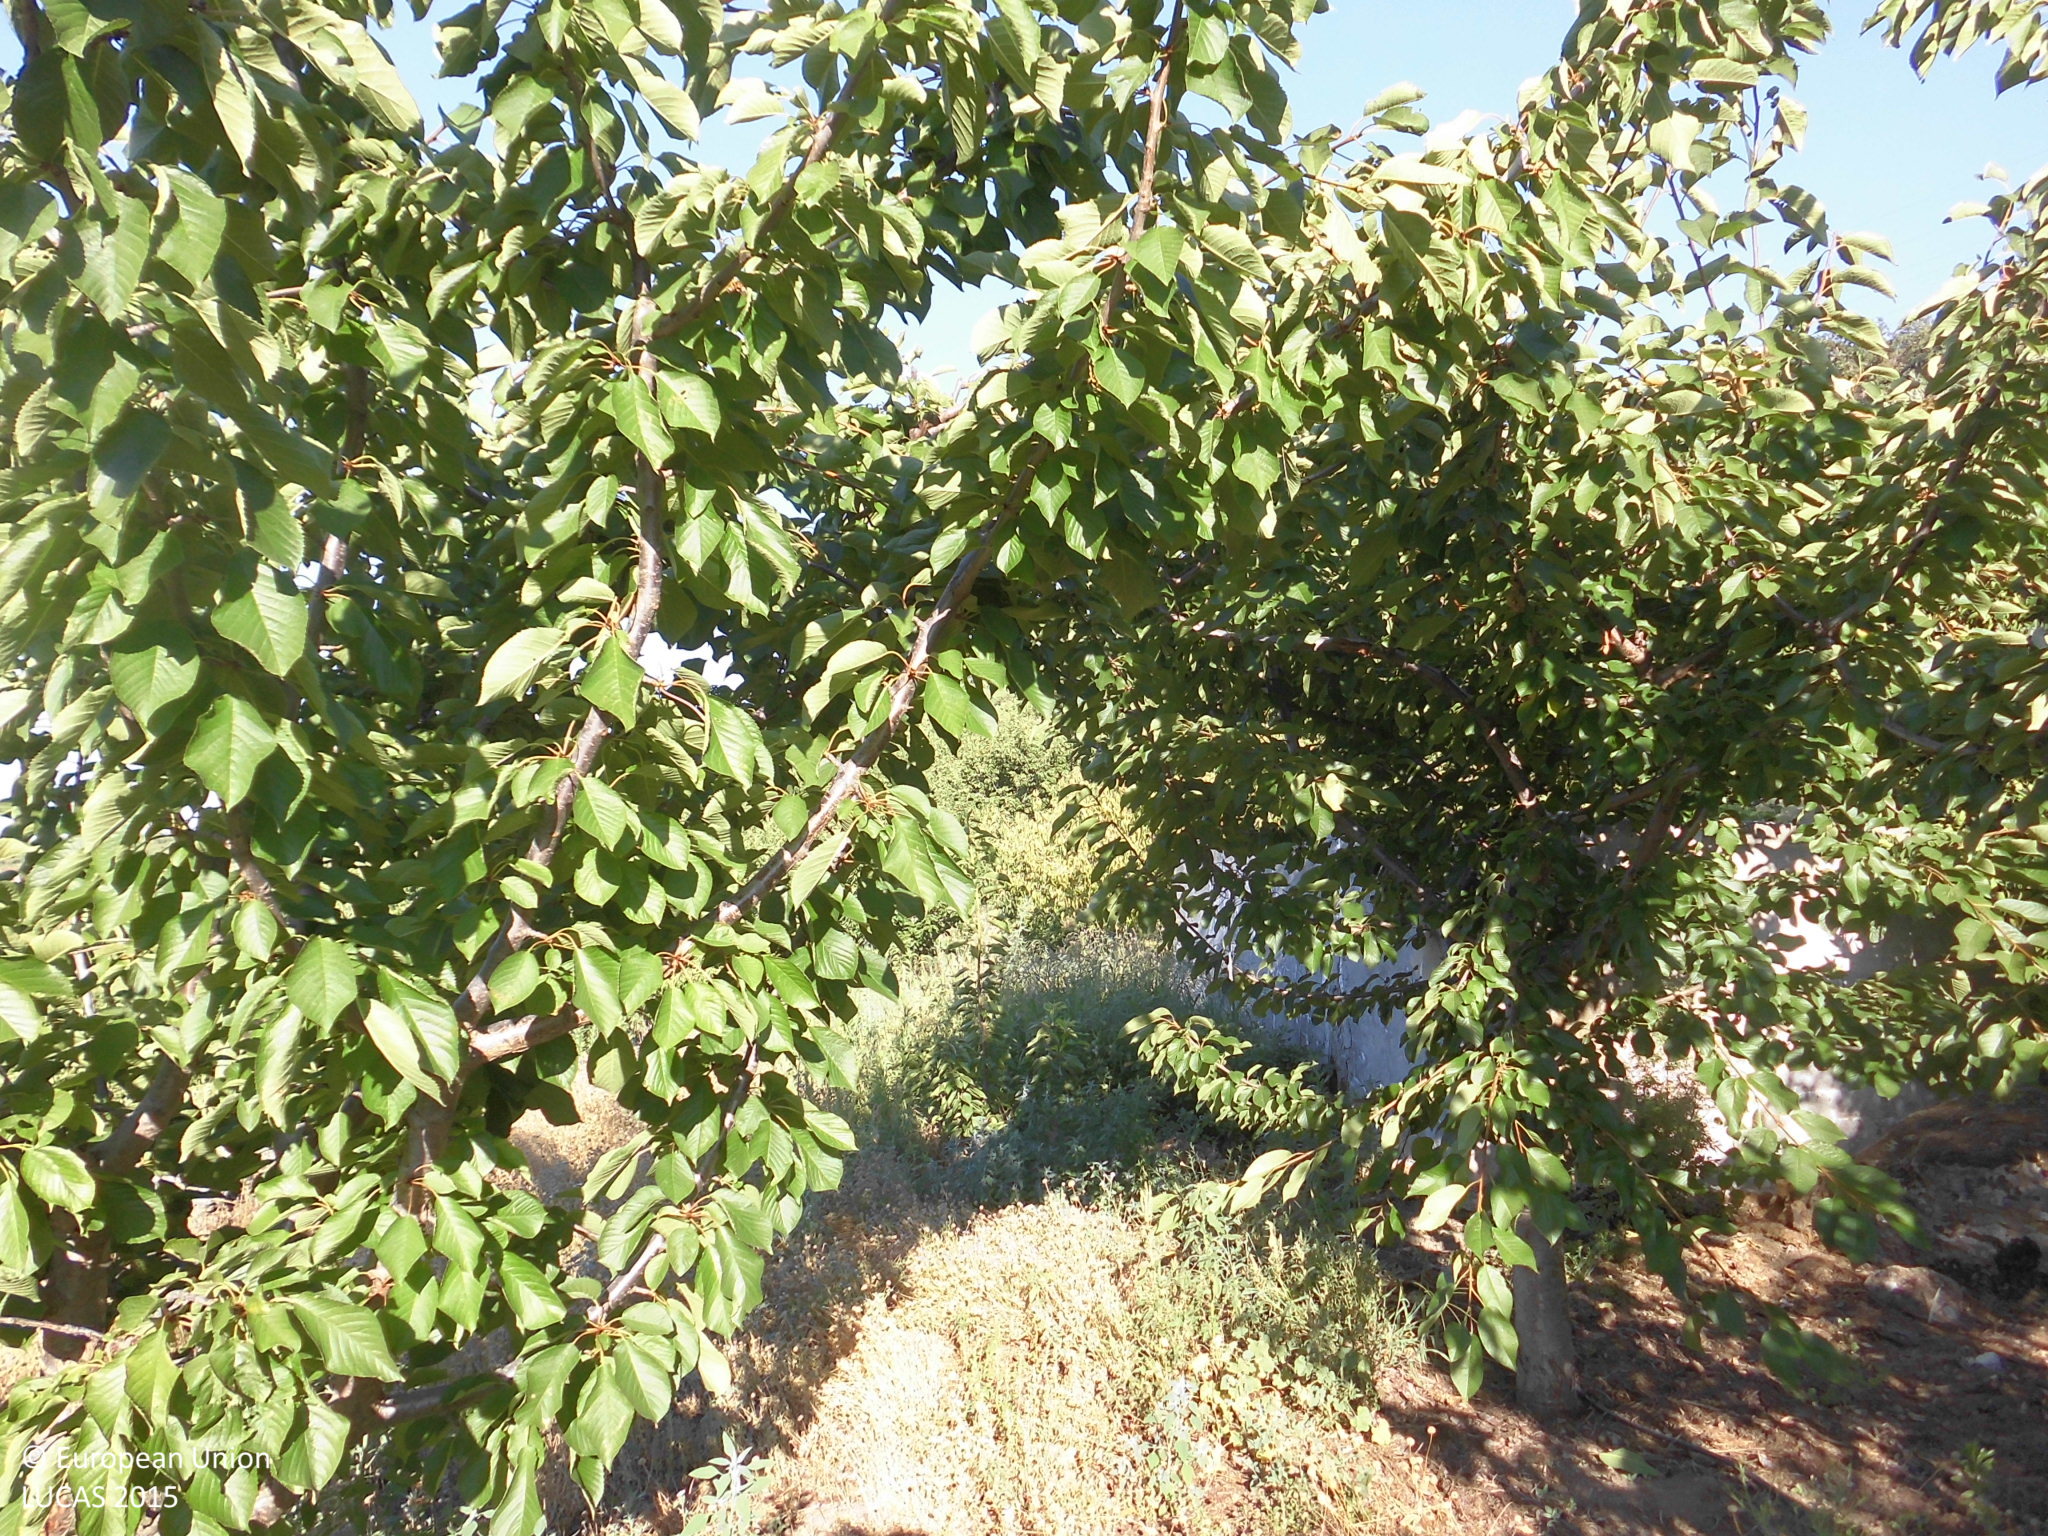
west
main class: Cropland
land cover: Cherry fruit
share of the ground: 25 - 50 %
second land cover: Grassland without tree/shrub cover
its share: > 75 %
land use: Agriculture (excluding fallow land and kitchen gardens)
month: July
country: ES
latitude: 40.1635
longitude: -5.8612
